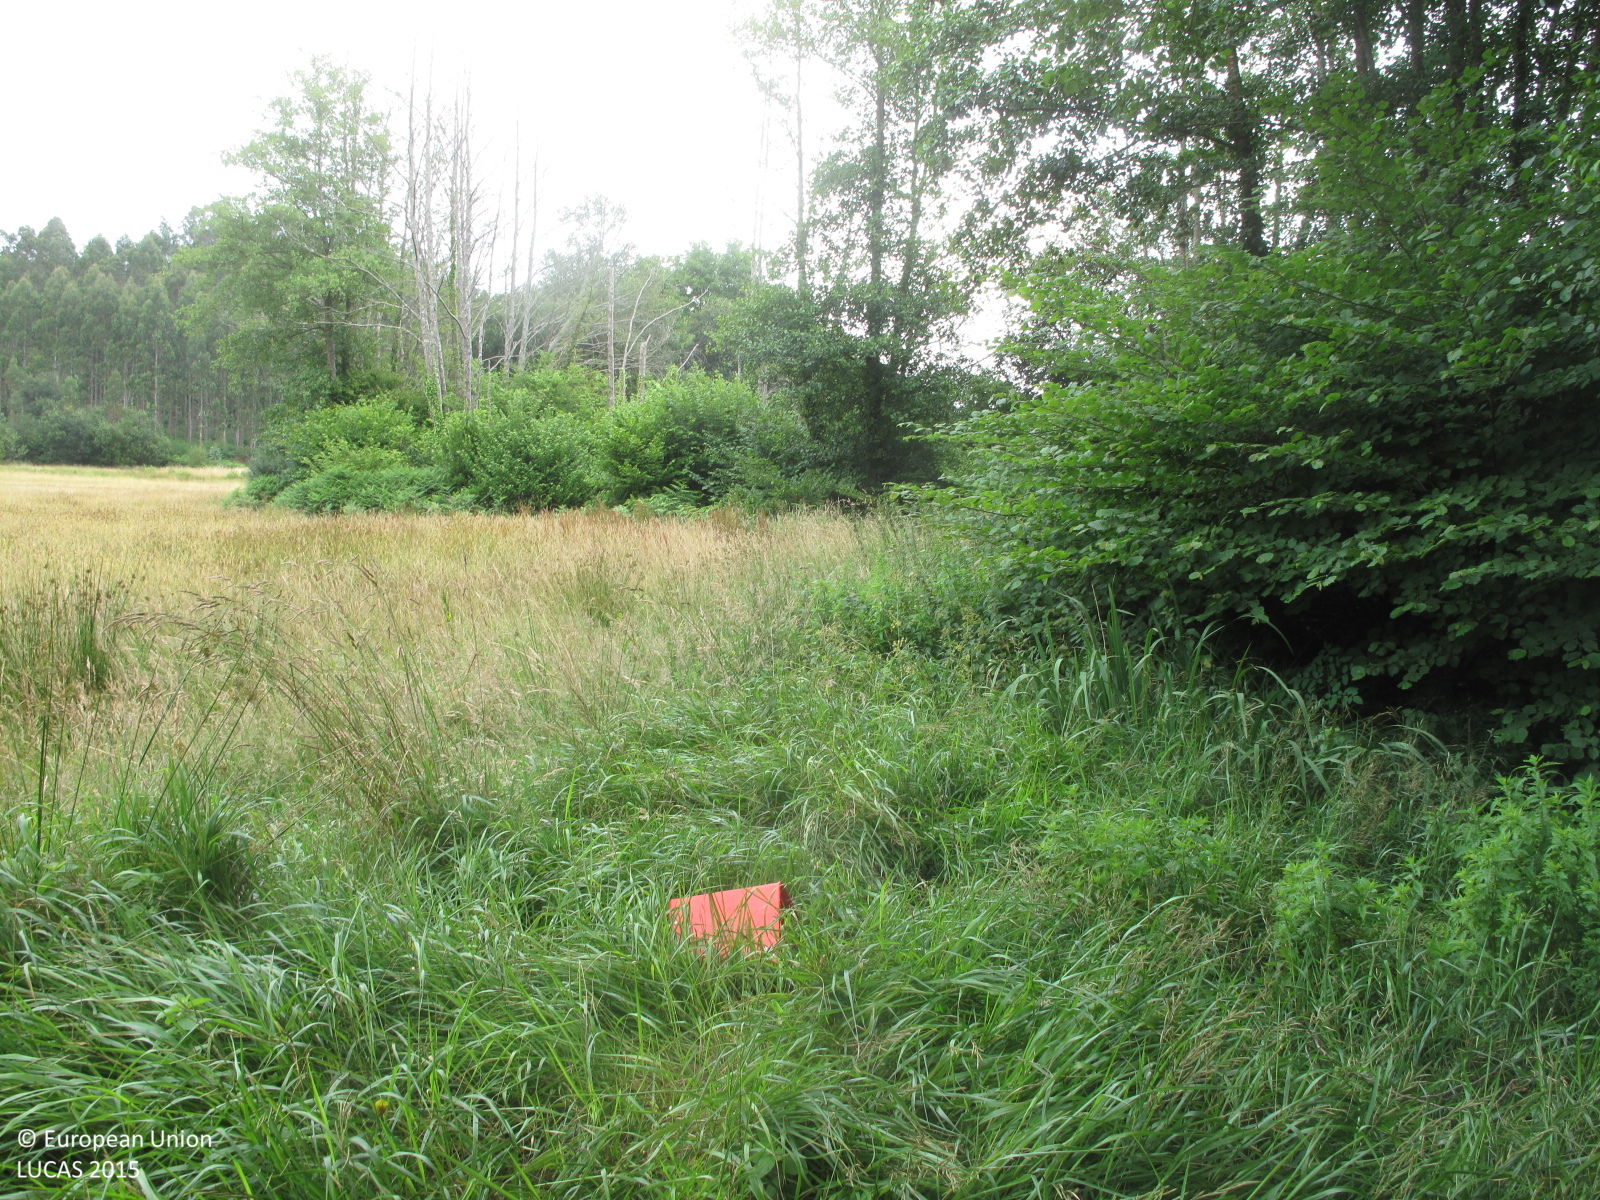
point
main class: Grassland
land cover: Grassland without tree/shrub cover
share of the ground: > 75 %
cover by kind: herbaceous plants 100 %
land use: Agriculture (excluding fallow land and kitchen gardens)
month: July
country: ES
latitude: 43.5828
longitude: -8.0434
